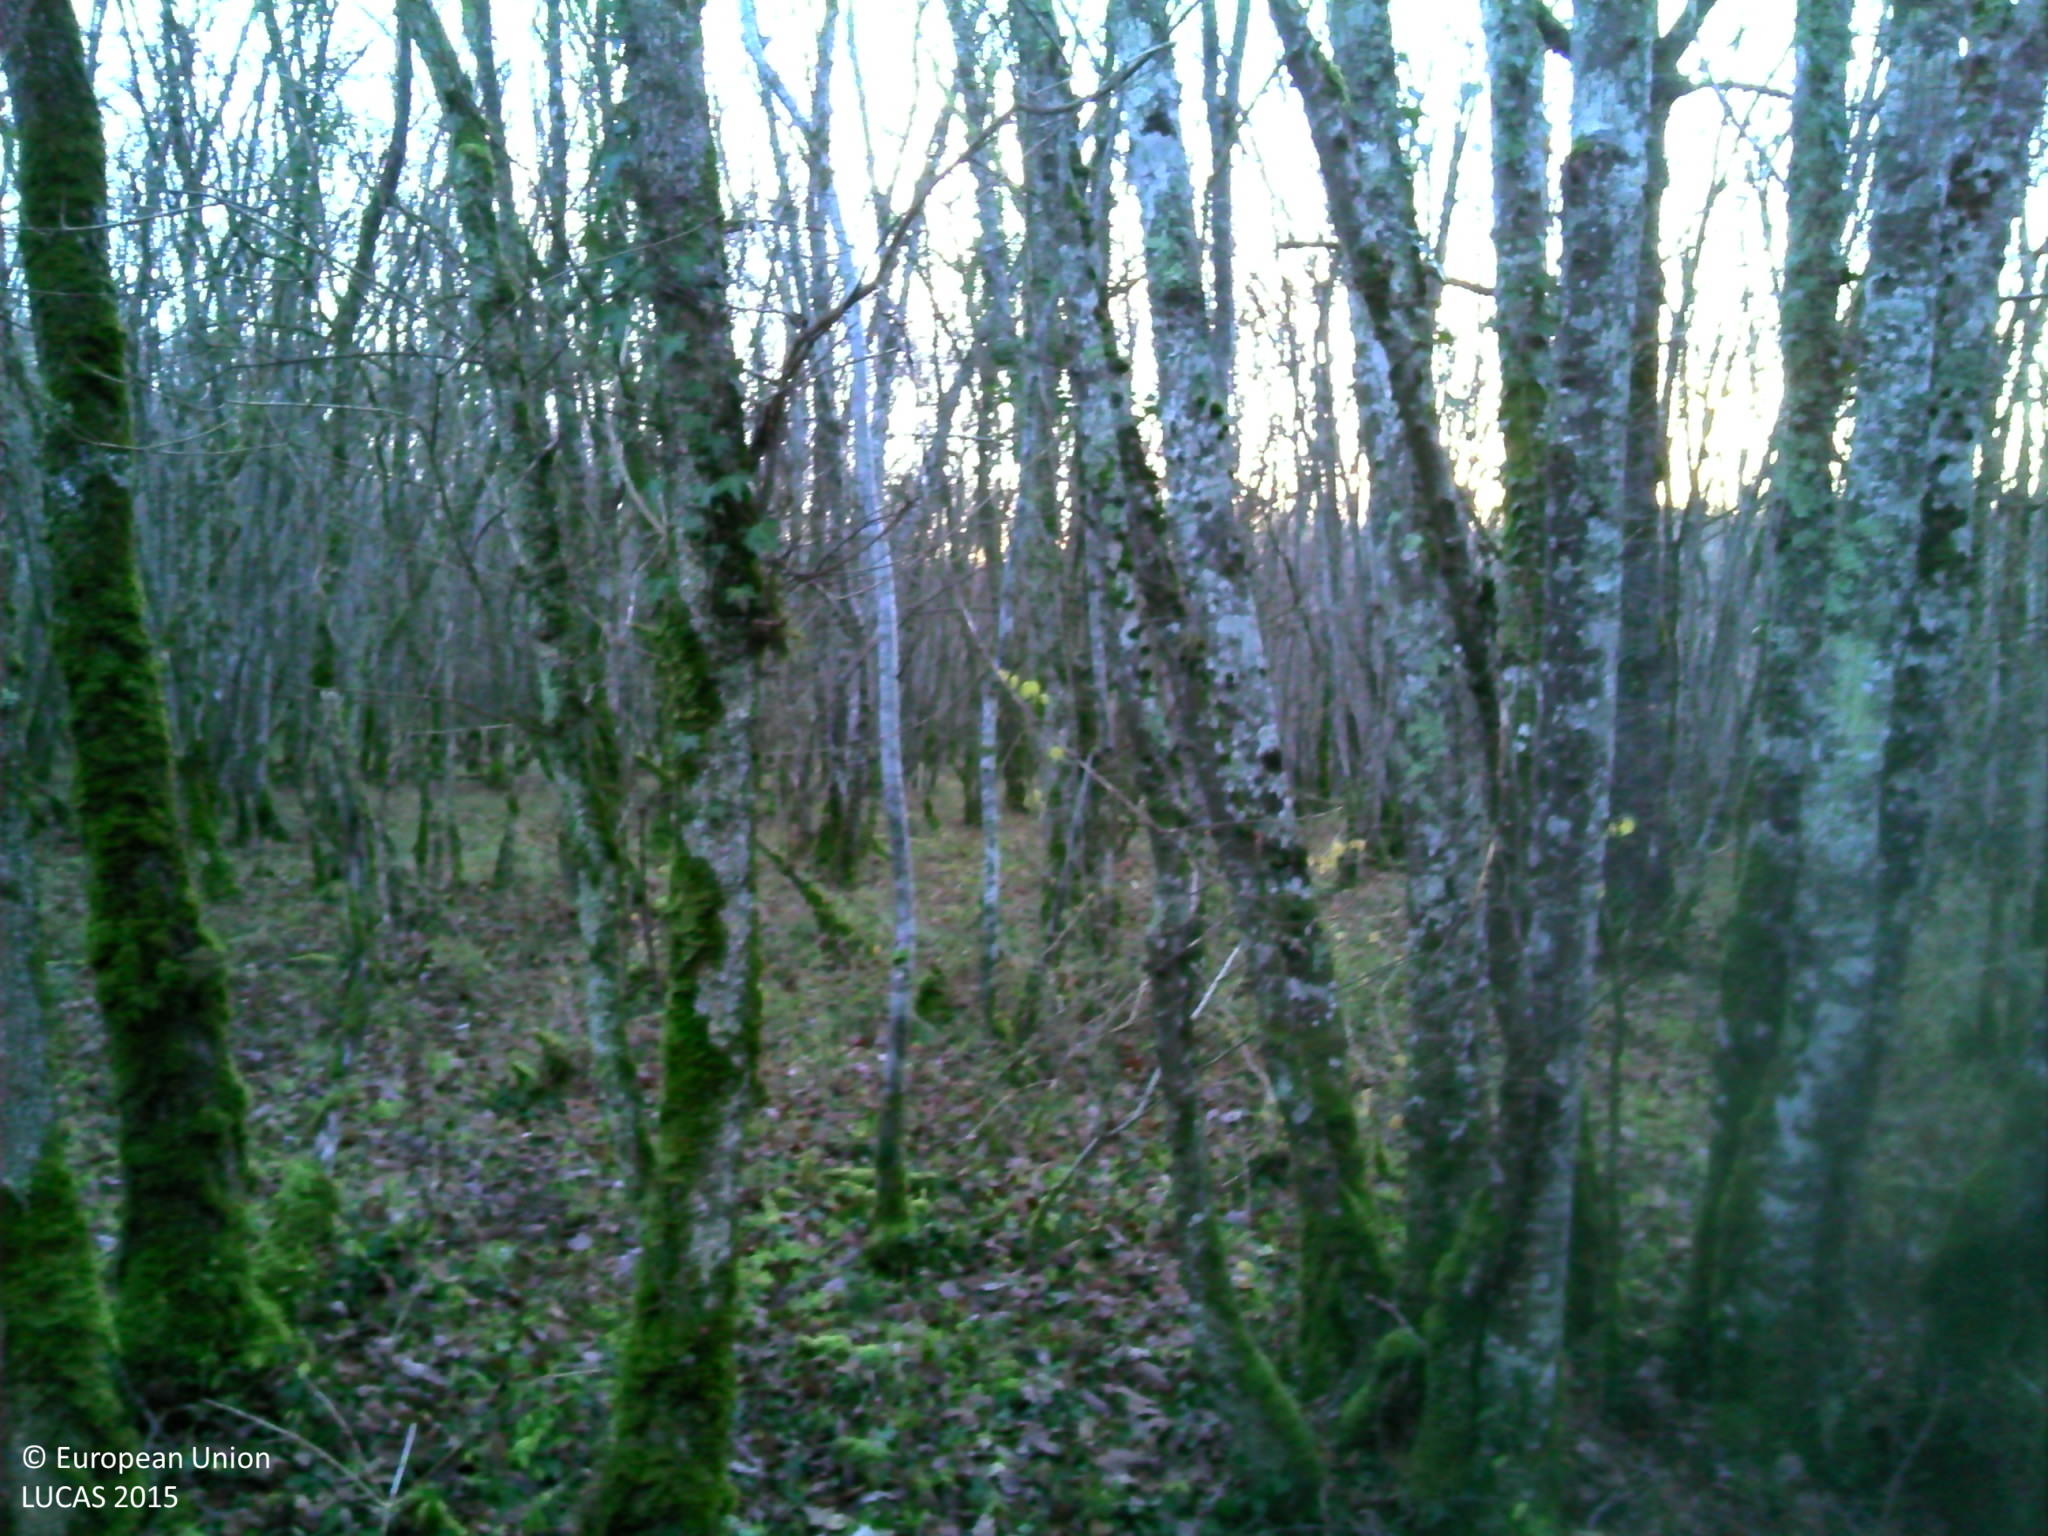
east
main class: Woodland
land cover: Broadleaved woodland
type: mesophytic deciduous forest
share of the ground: > 75 %
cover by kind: broadleaved forest trees 100 %
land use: Forestry
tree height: > 5 m
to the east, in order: Broadleaved woodland; Tracks; Broadleaved woodland
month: December
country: FR
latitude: 47.3829
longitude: 3.5193
